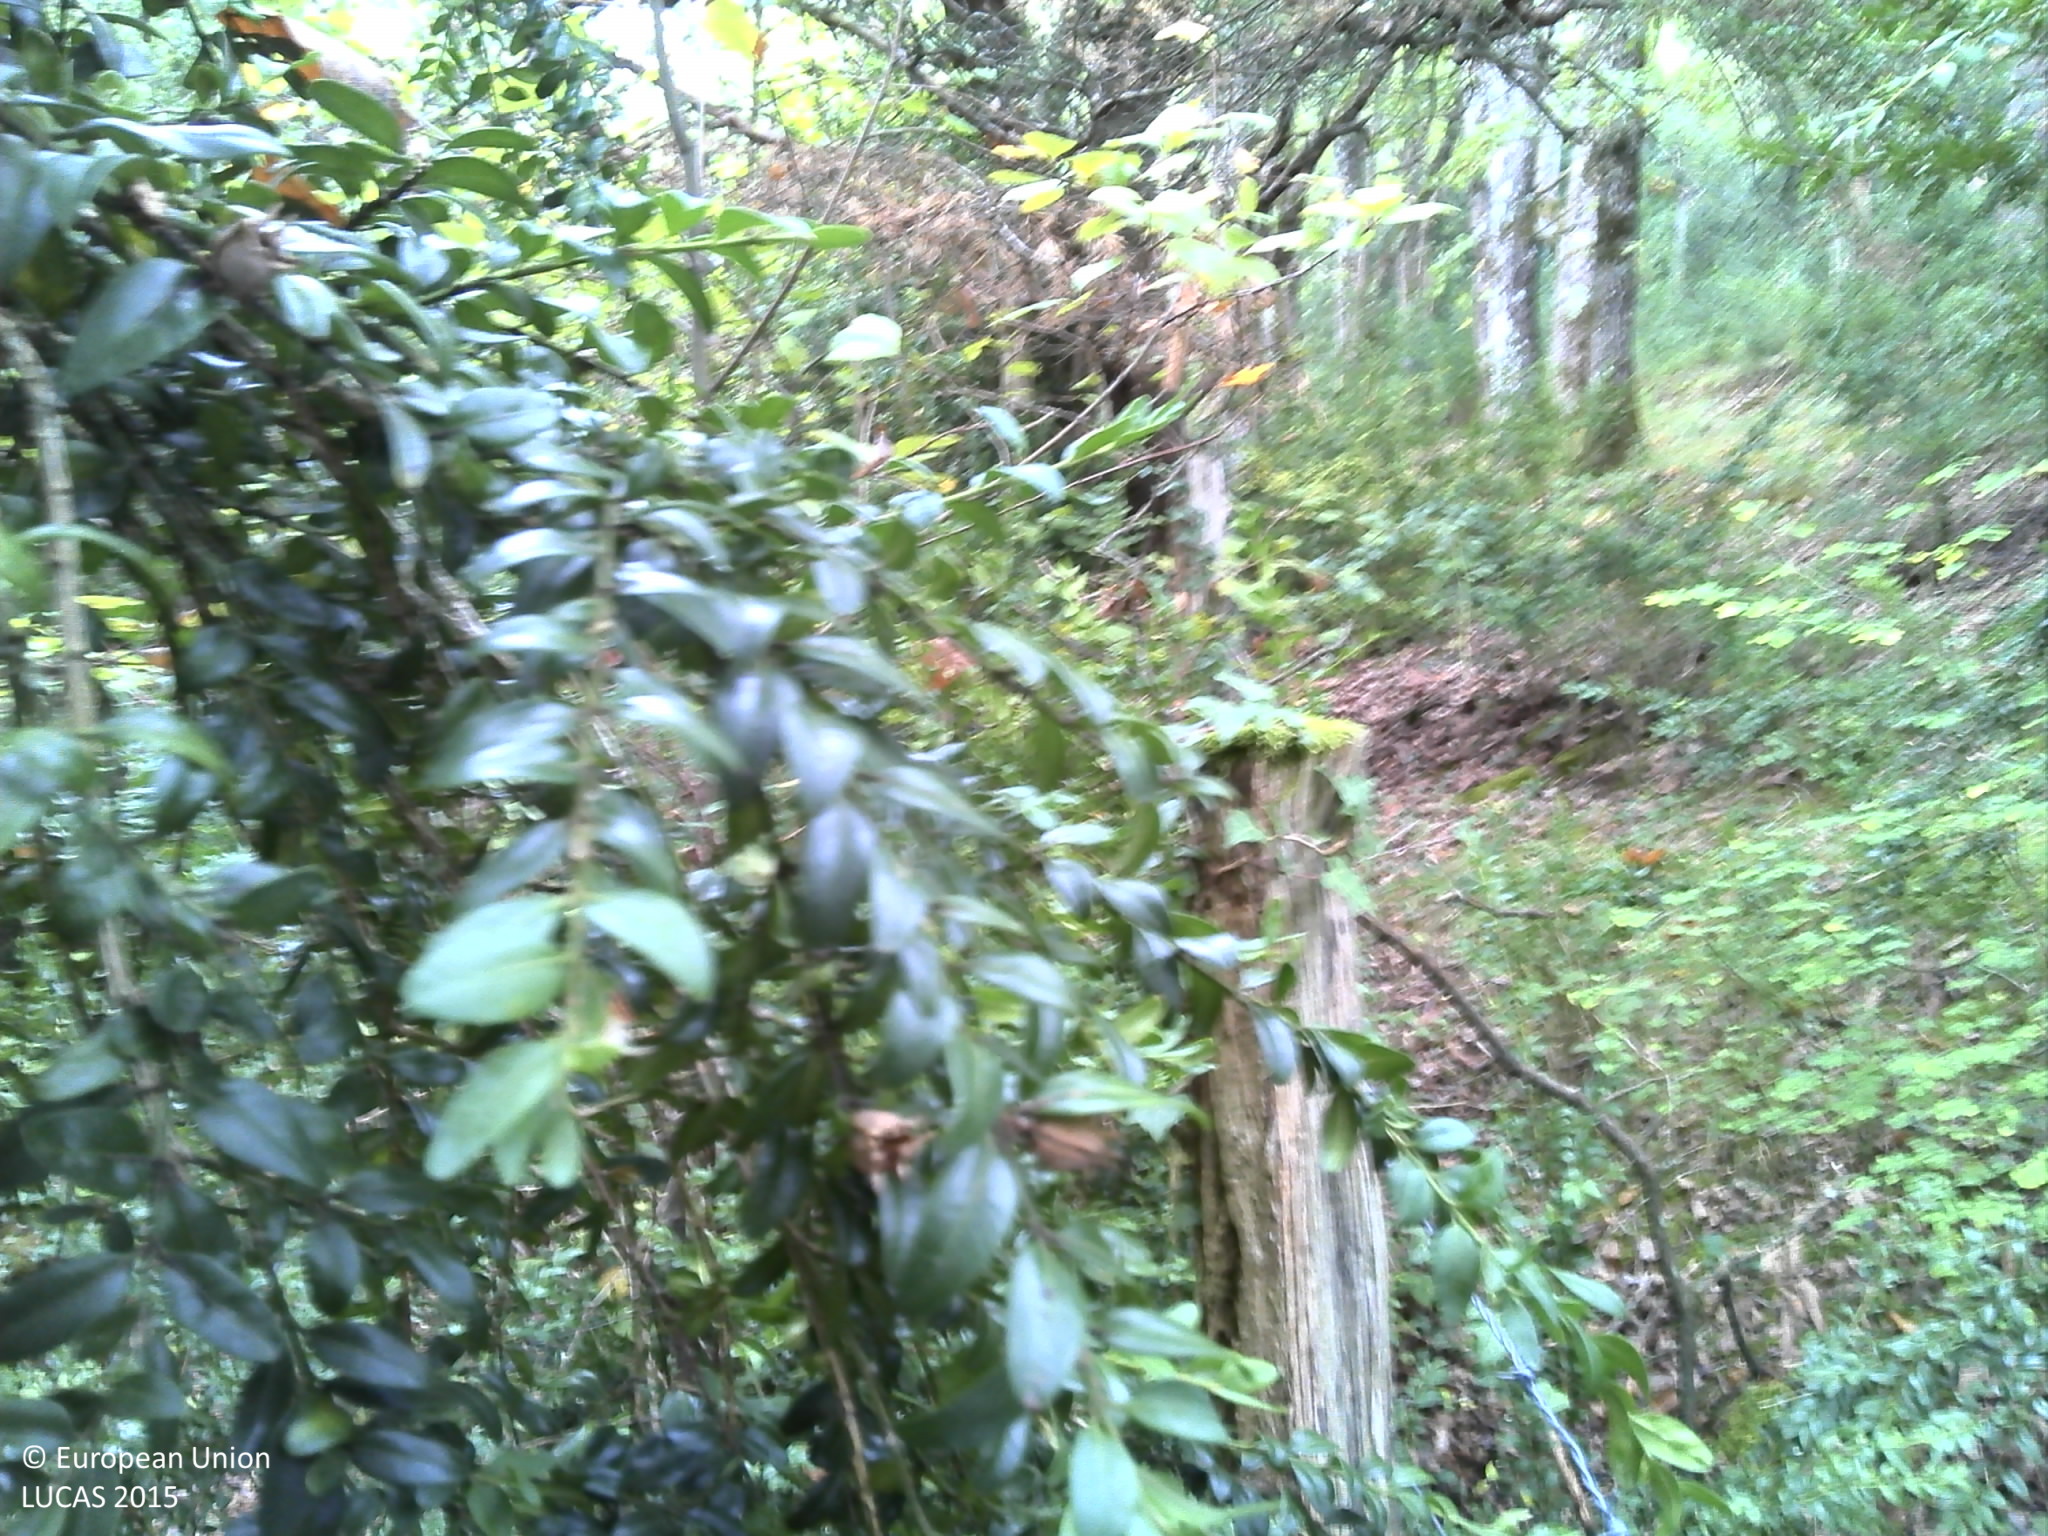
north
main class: Woodland
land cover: Broadleaved woodland
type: acidophilous oak and oak-birch forest
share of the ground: 50 - 75 %
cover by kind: broadleaved forest trees 50 %, herbaceous plants 30 %, shrubs 20 %
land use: Forestry
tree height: > 5 m
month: October
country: FR
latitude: 46.3241
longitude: 5.3920
